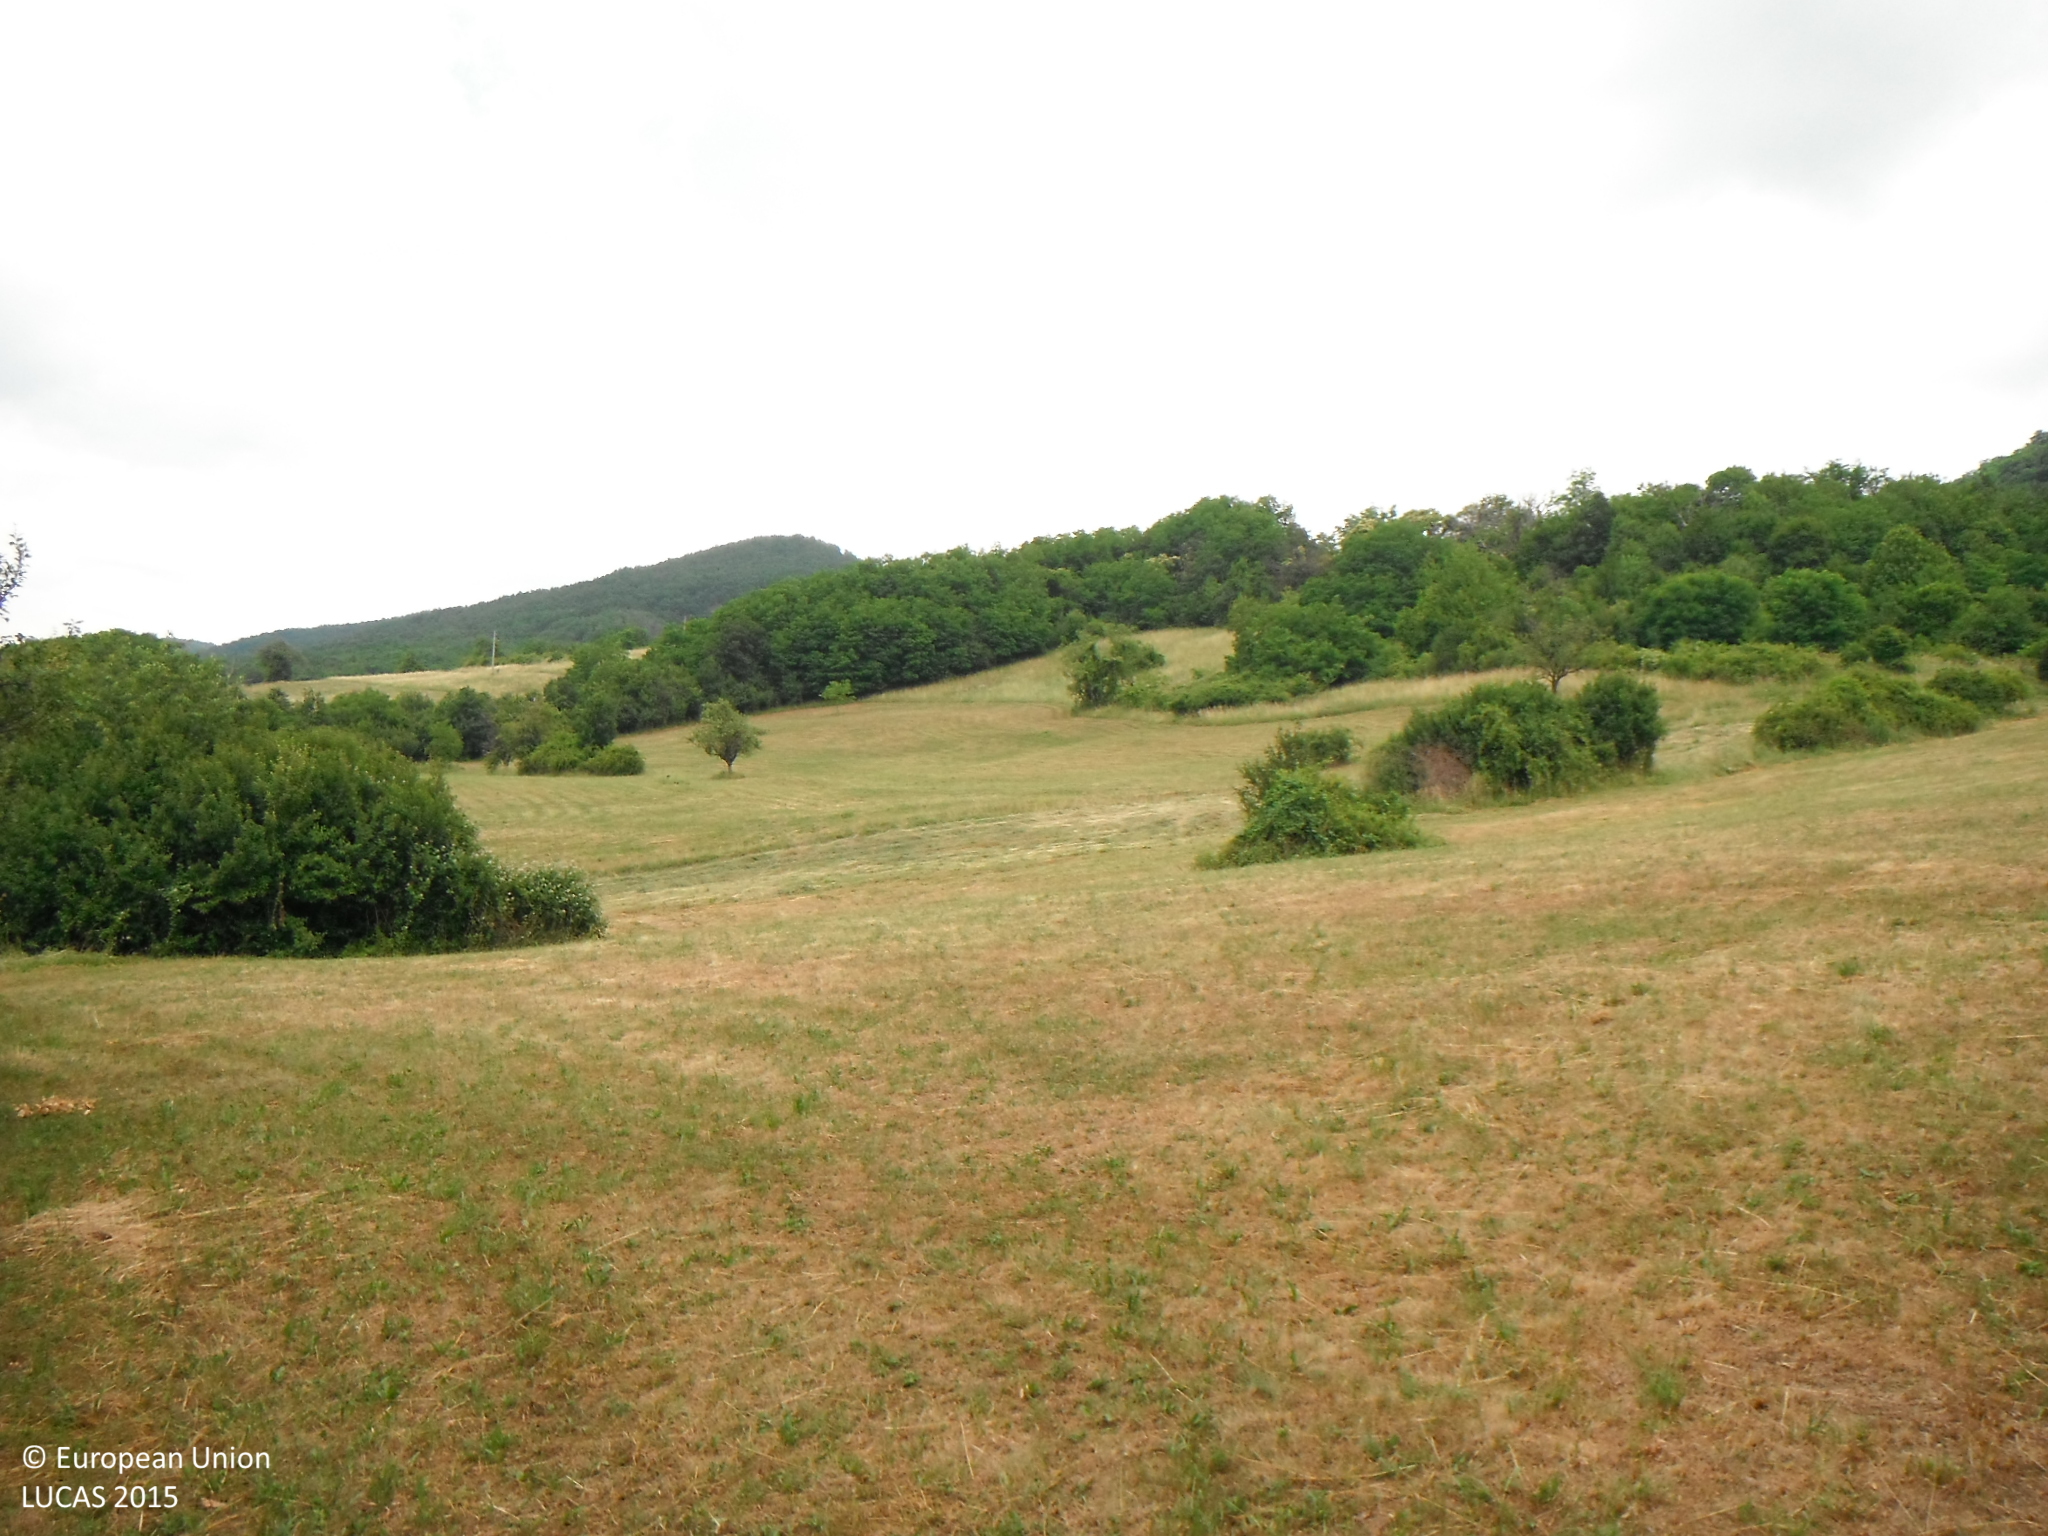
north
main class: Cropland
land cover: Pear fruit
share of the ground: 25 - 50 %
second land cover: Grassland without tree/shrub cover
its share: > 75 %
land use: Kitchen garden
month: June
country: SK
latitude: 48.2283
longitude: 19.2976
